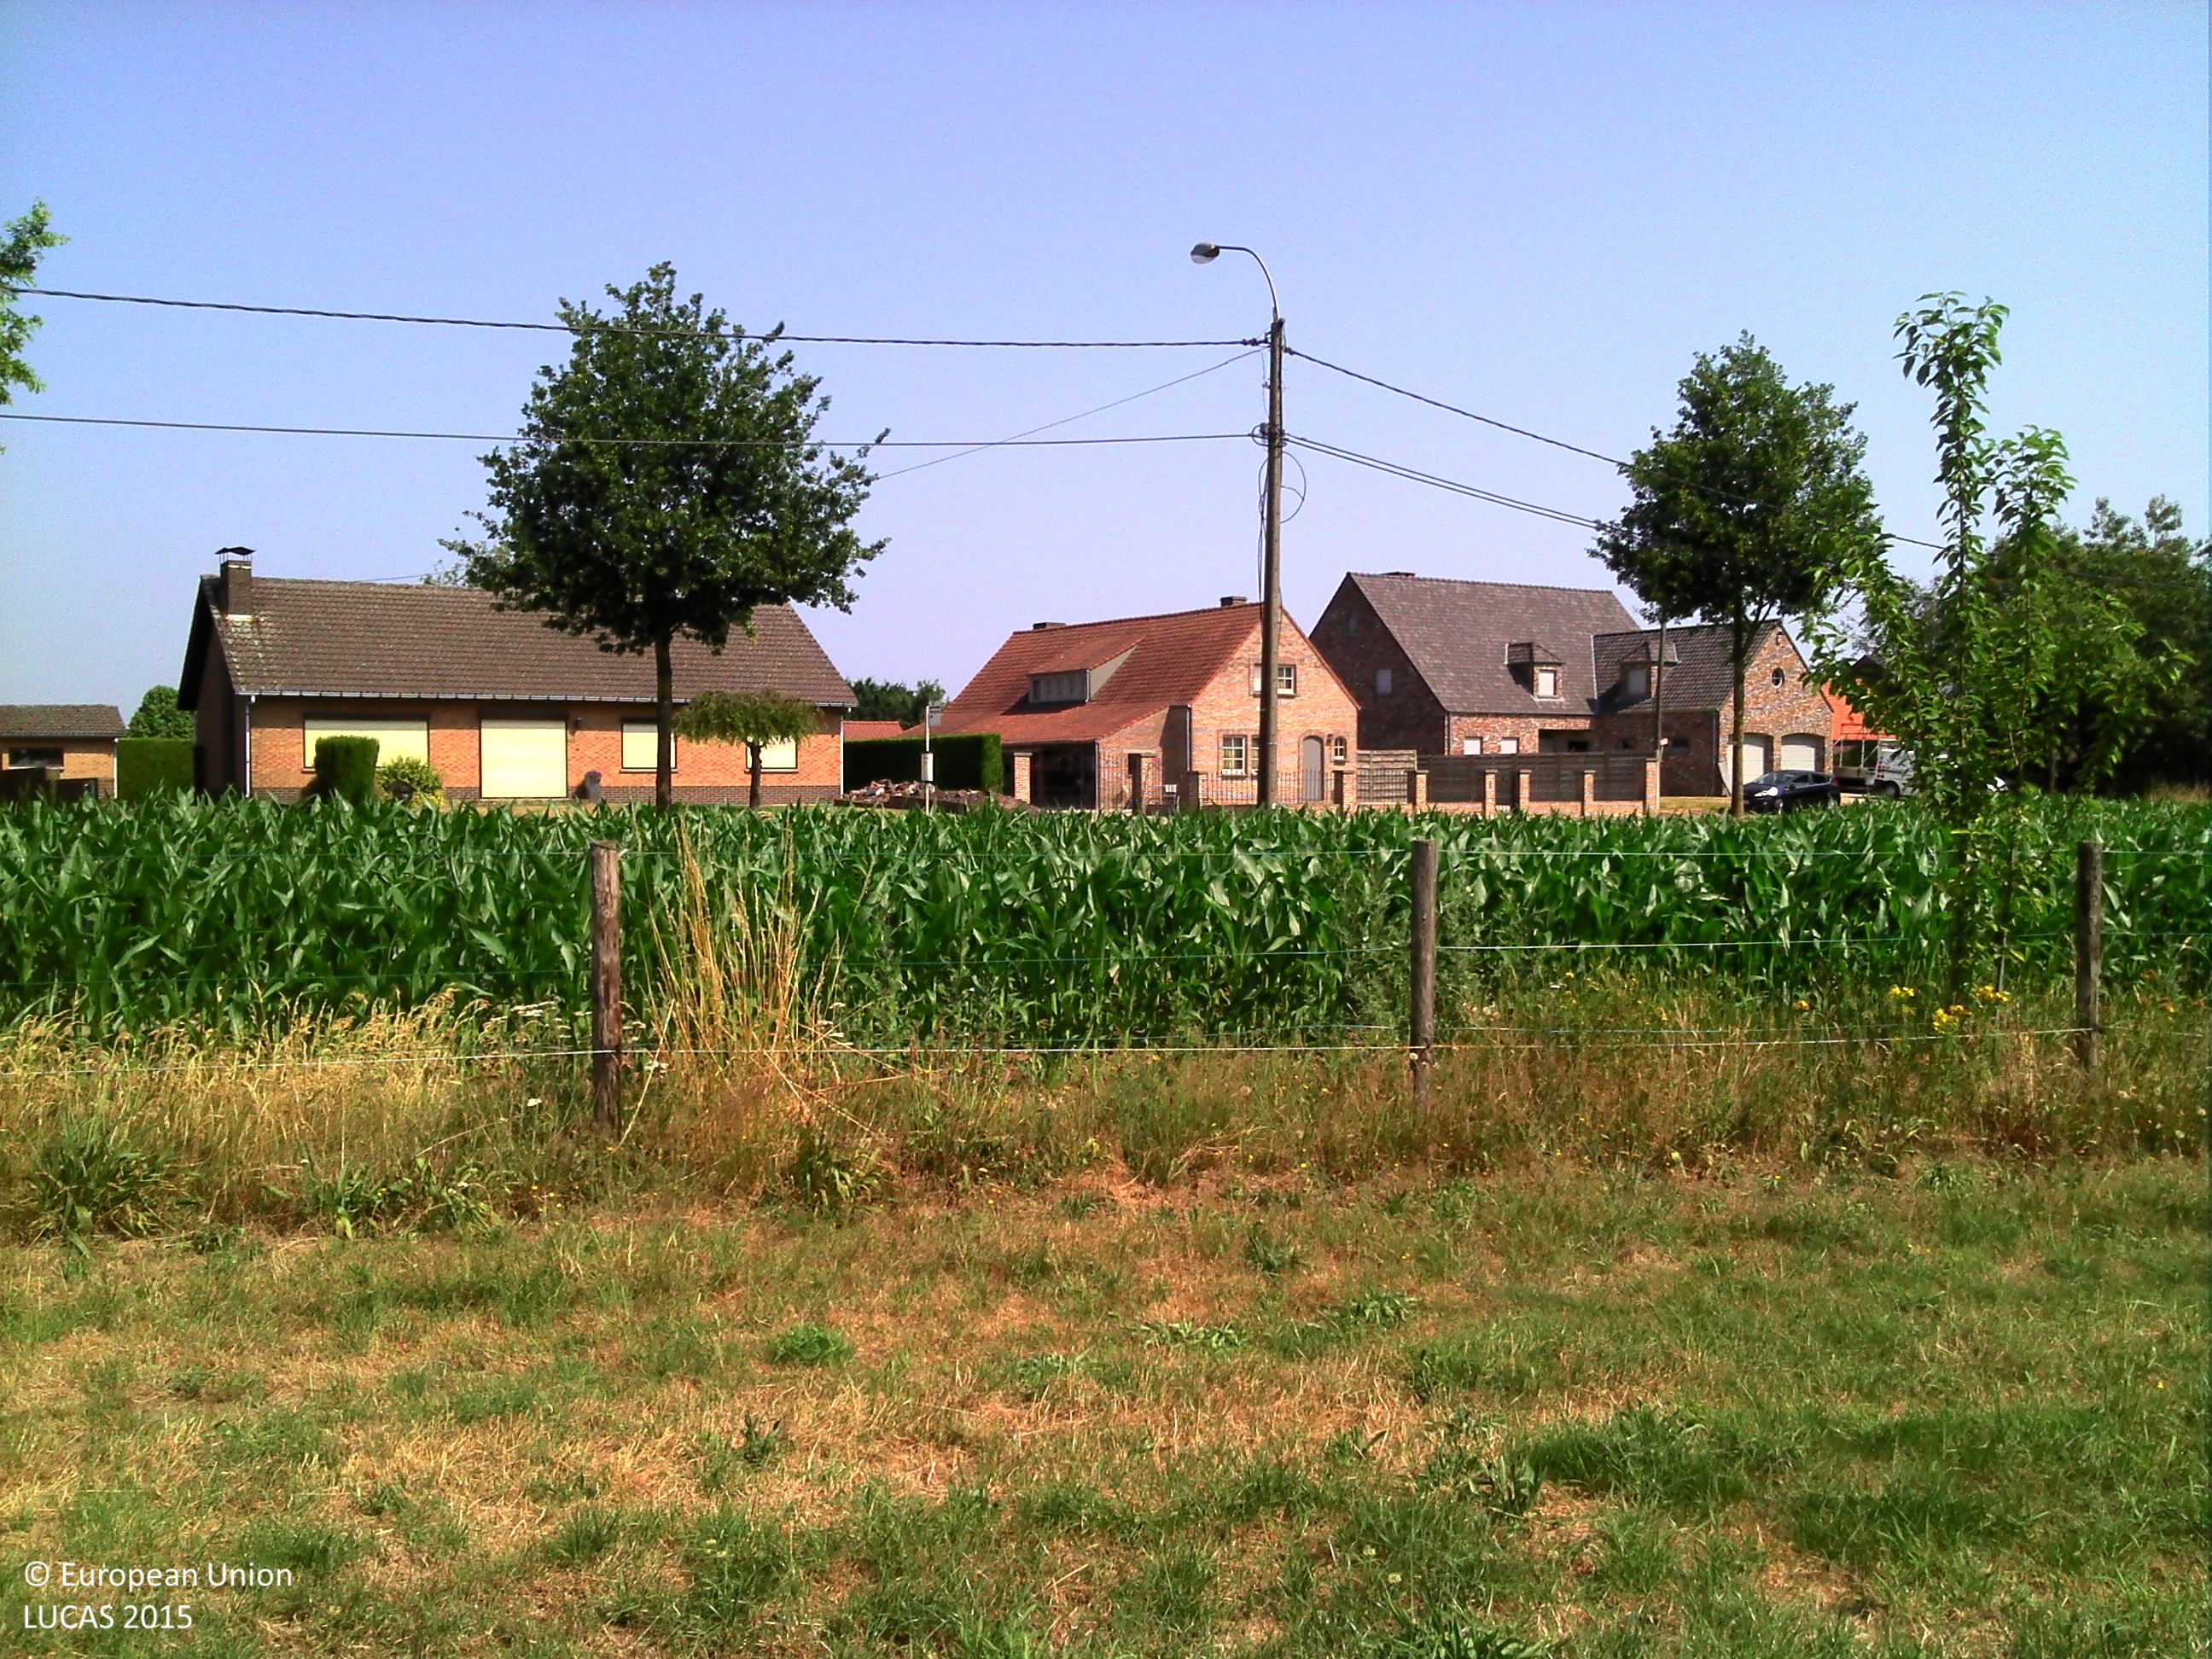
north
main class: Grassland
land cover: Grassland without tree/shrub cover
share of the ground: > 75 %
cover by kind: herbaceous plants 100 %
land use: Agriculture (excluding fallow land and kitchen gardens)
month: July
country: BE
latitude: 51.0849
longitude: 5.4727
